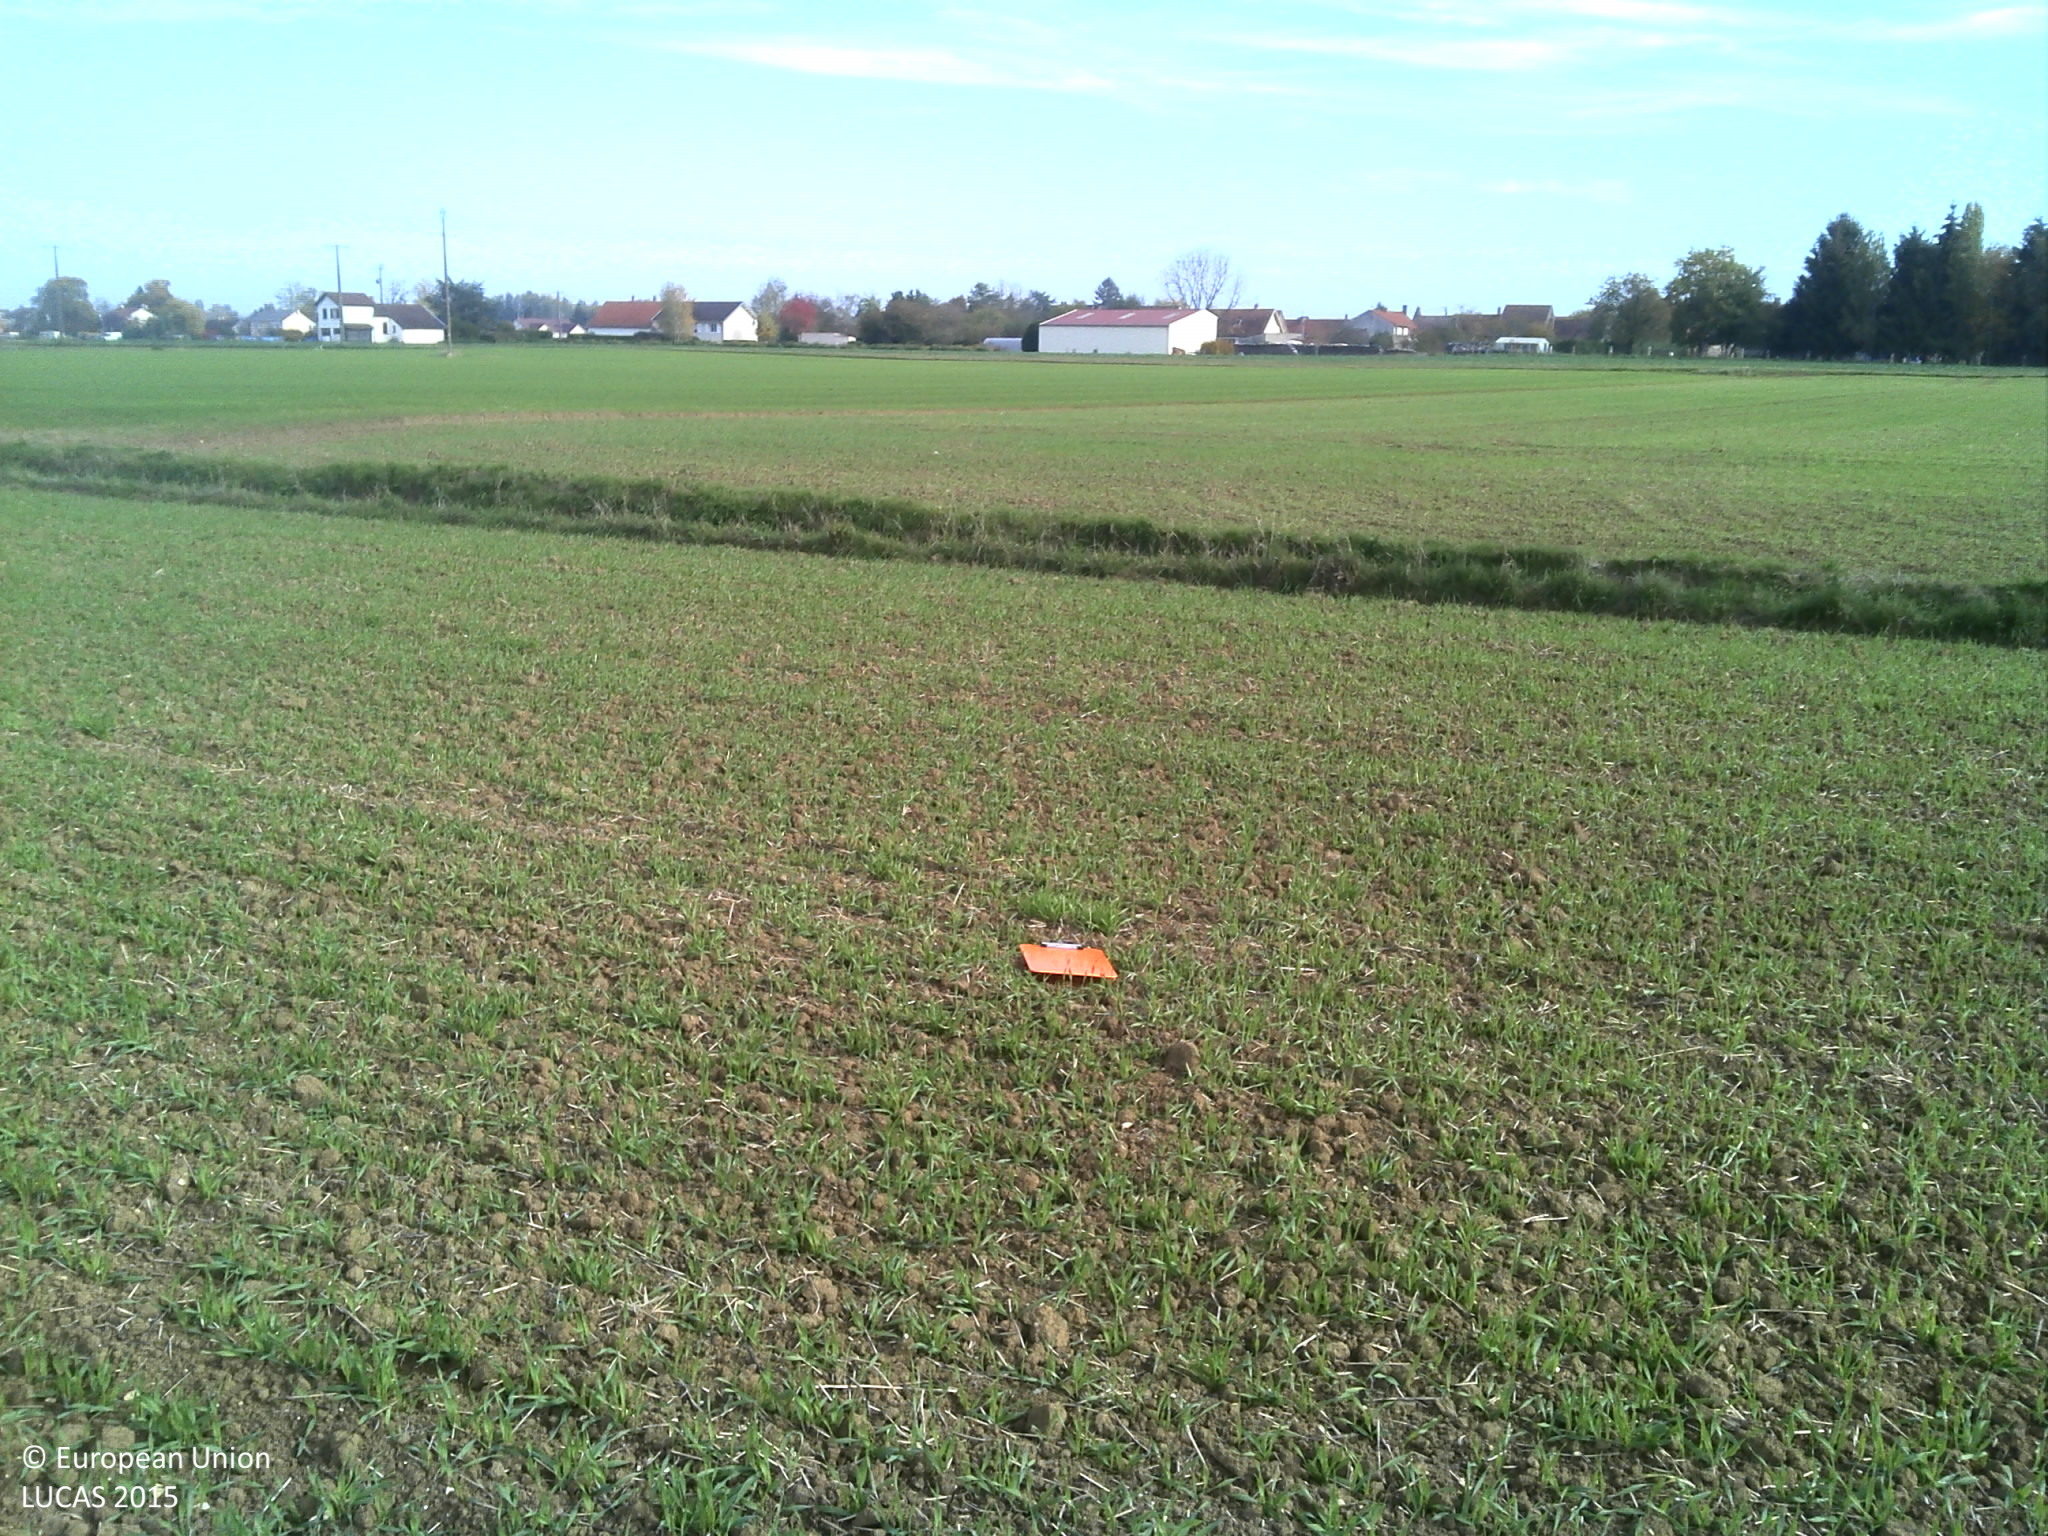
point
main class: Cropland
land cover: Common wheat
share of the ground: > 75 %
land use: Agriculture (excluding fallow land and kitchen gardens)
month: October
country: FR
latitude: 47.1484
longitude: 5.2668
